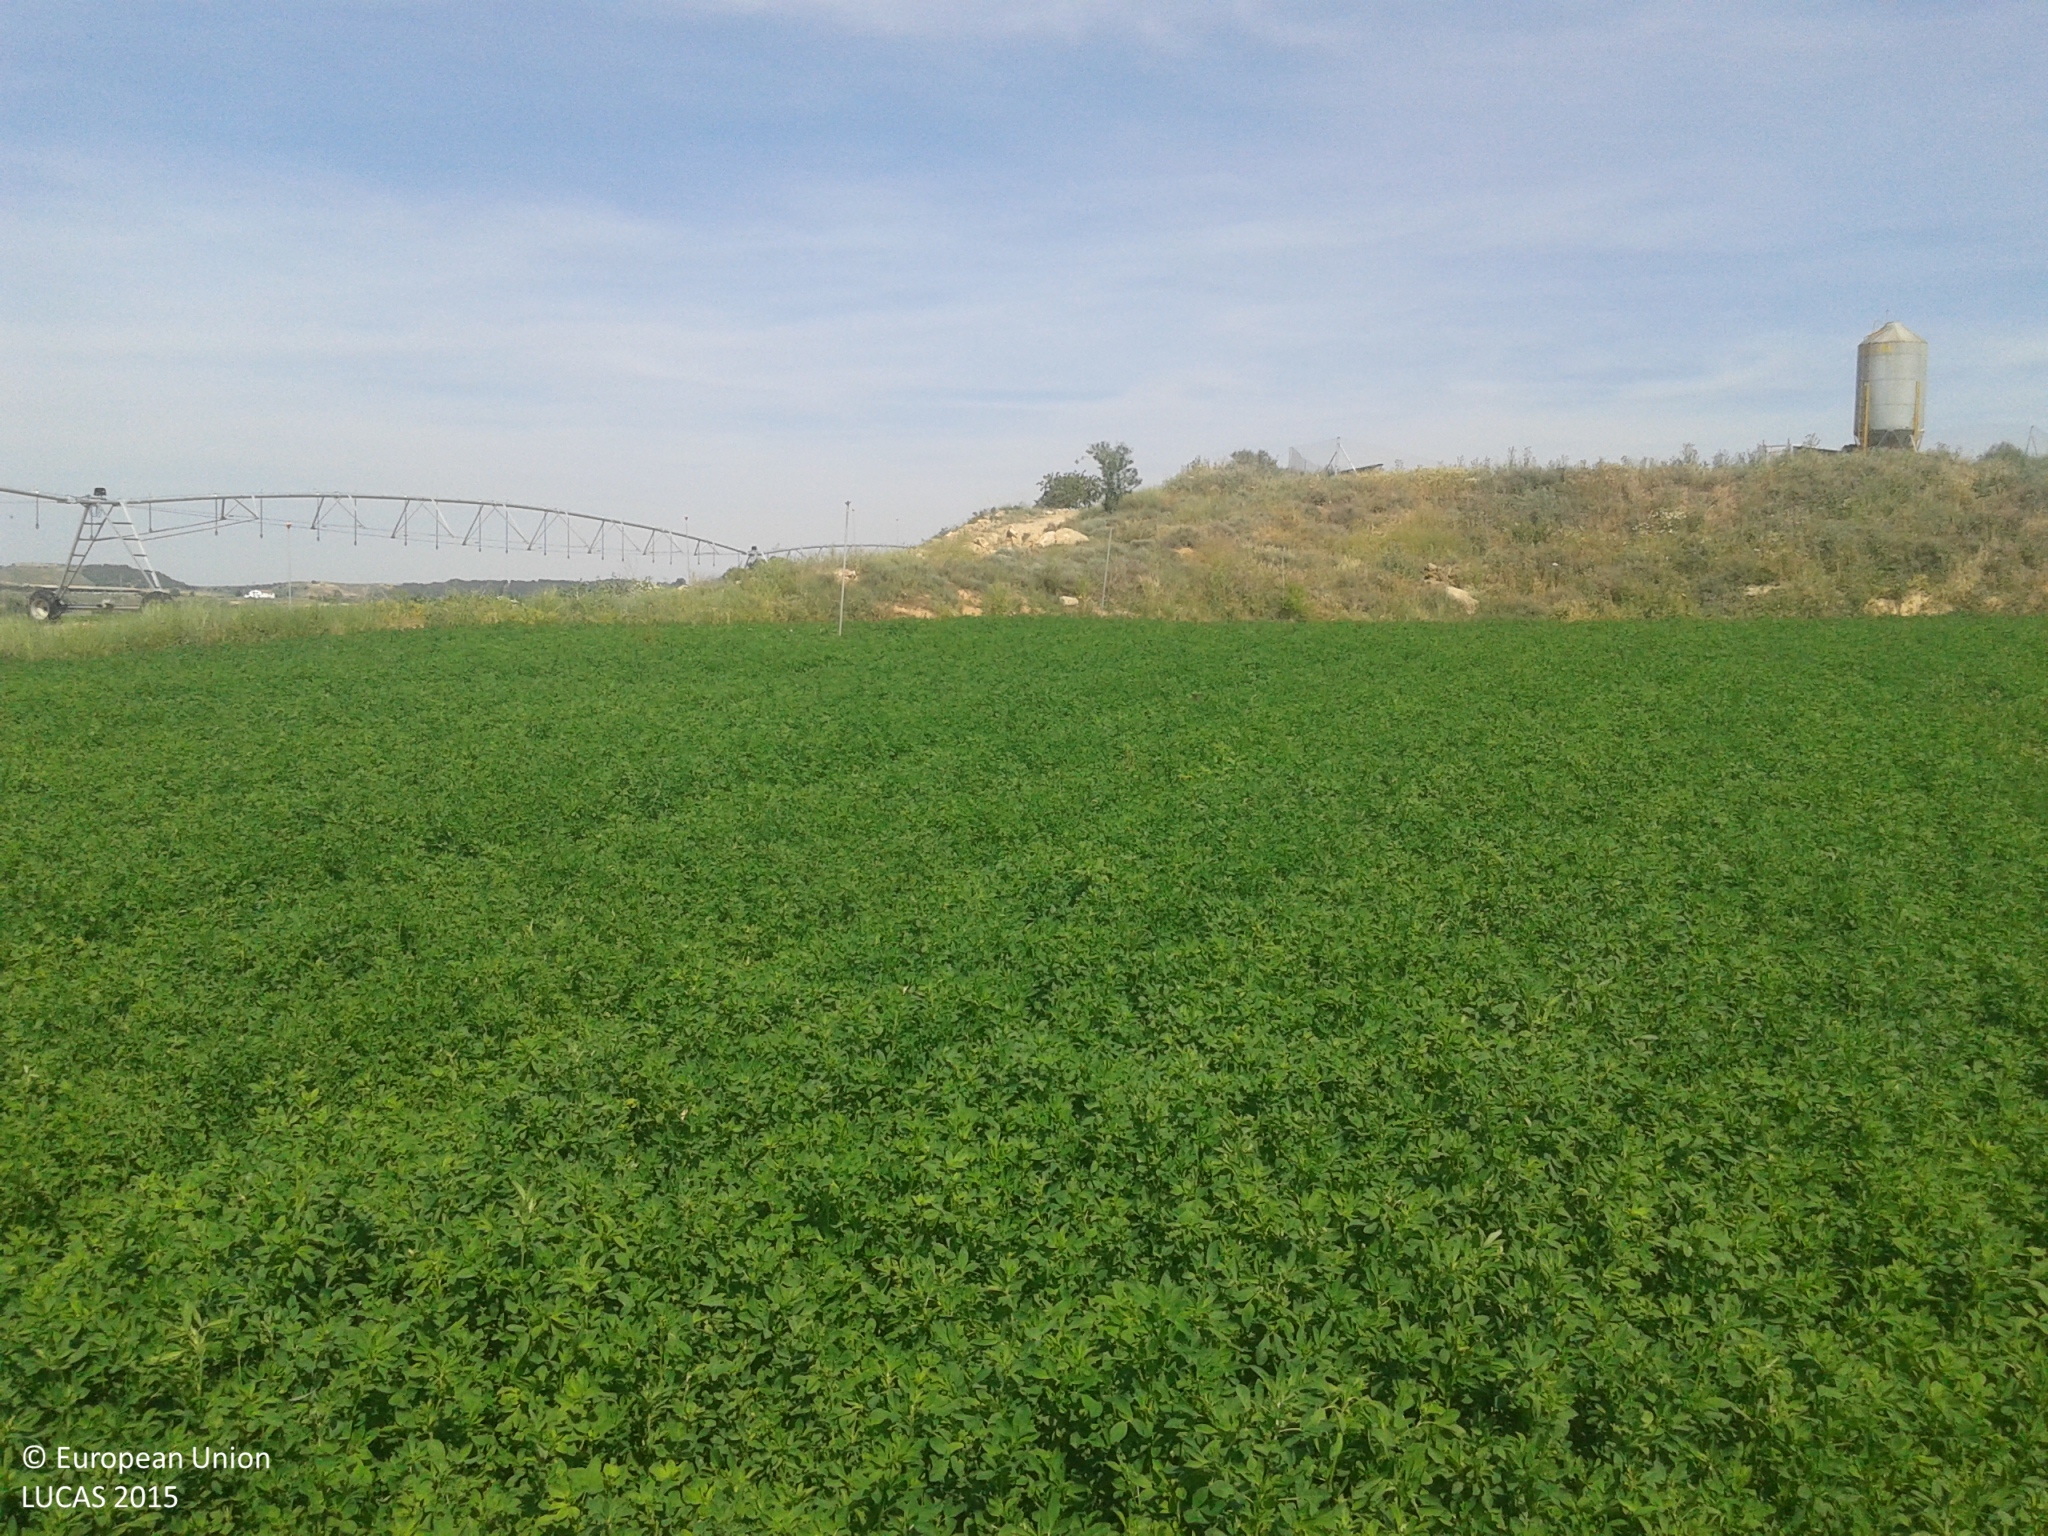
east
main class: Cropland
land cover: Lucerne
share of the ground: > 75 %
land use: Agriculture (excluding fallow land and kitchen gardens)
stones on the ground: < 10 %
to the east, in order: Lucerne; Shrubland without tree cover; Tracks; Shrubland with sparse tree cover; Maize
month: May
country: ES
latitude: 41.8079
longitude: 0.5128
